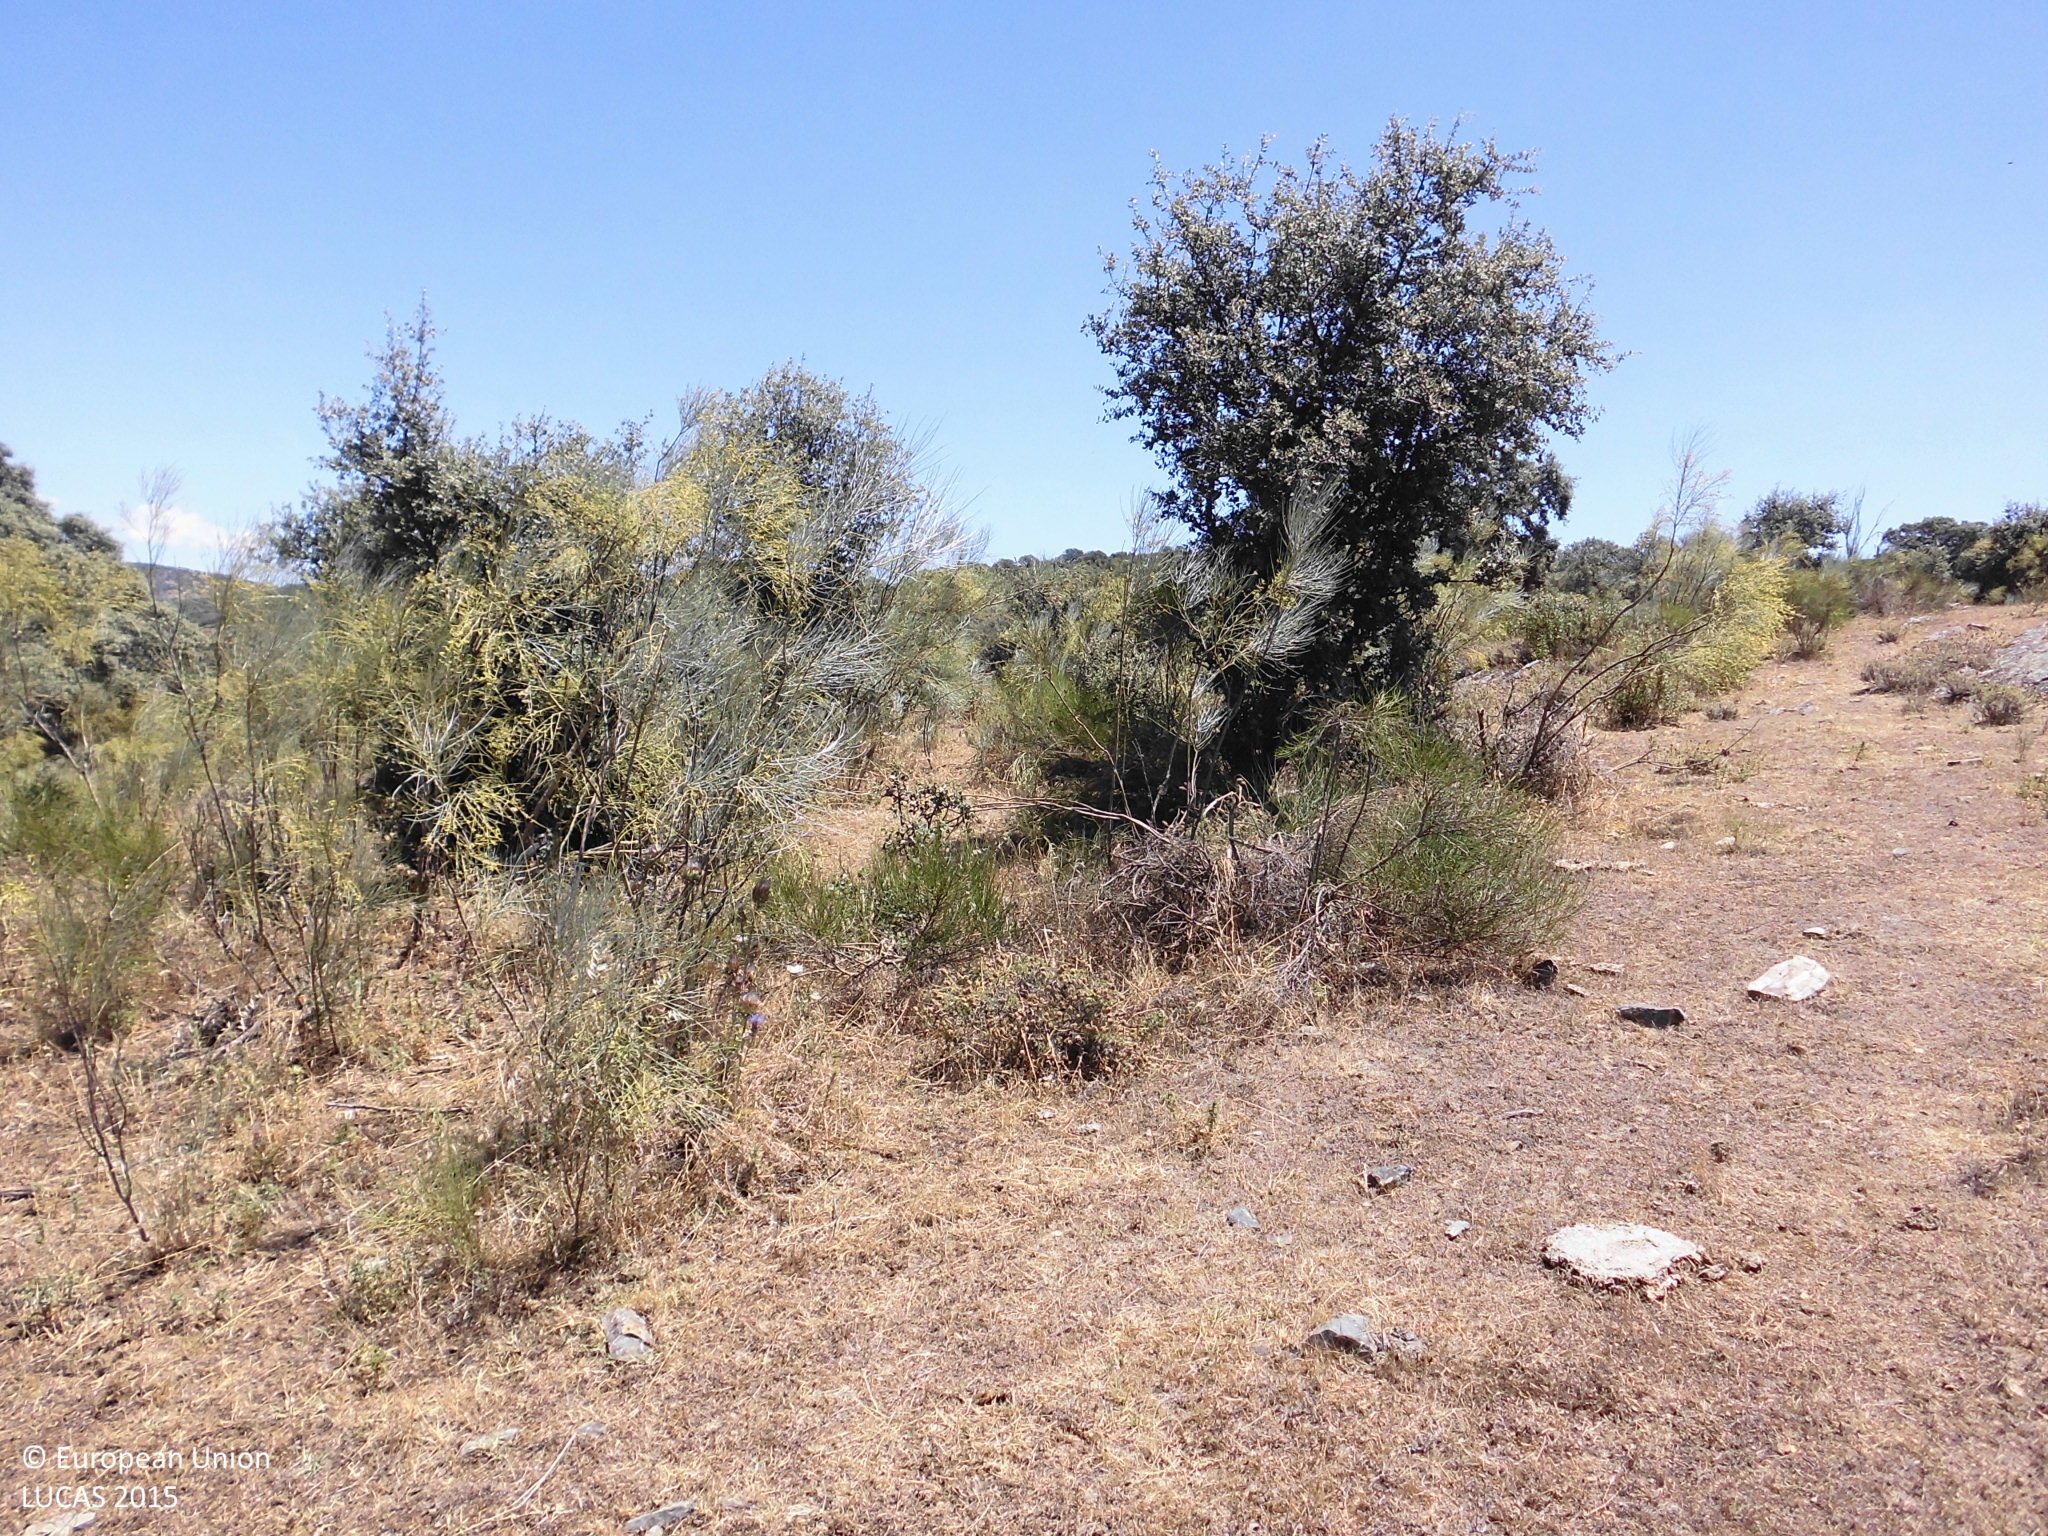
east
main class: Shrubland
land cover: Shrubland without tree cover
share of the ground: 10 - 25 %
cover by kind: herbaceous plants 85 %, shrubs 15 %
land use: Agriculture (excluding fallow land and kitchen gardens)
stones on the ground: > 50 %
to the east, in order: Shrubland without tree cover; Fences; Shrubland without tree cover; Electric lines; Shrubland without tree cover
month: June
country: ES
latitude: 39.9944
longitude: -6.1054
